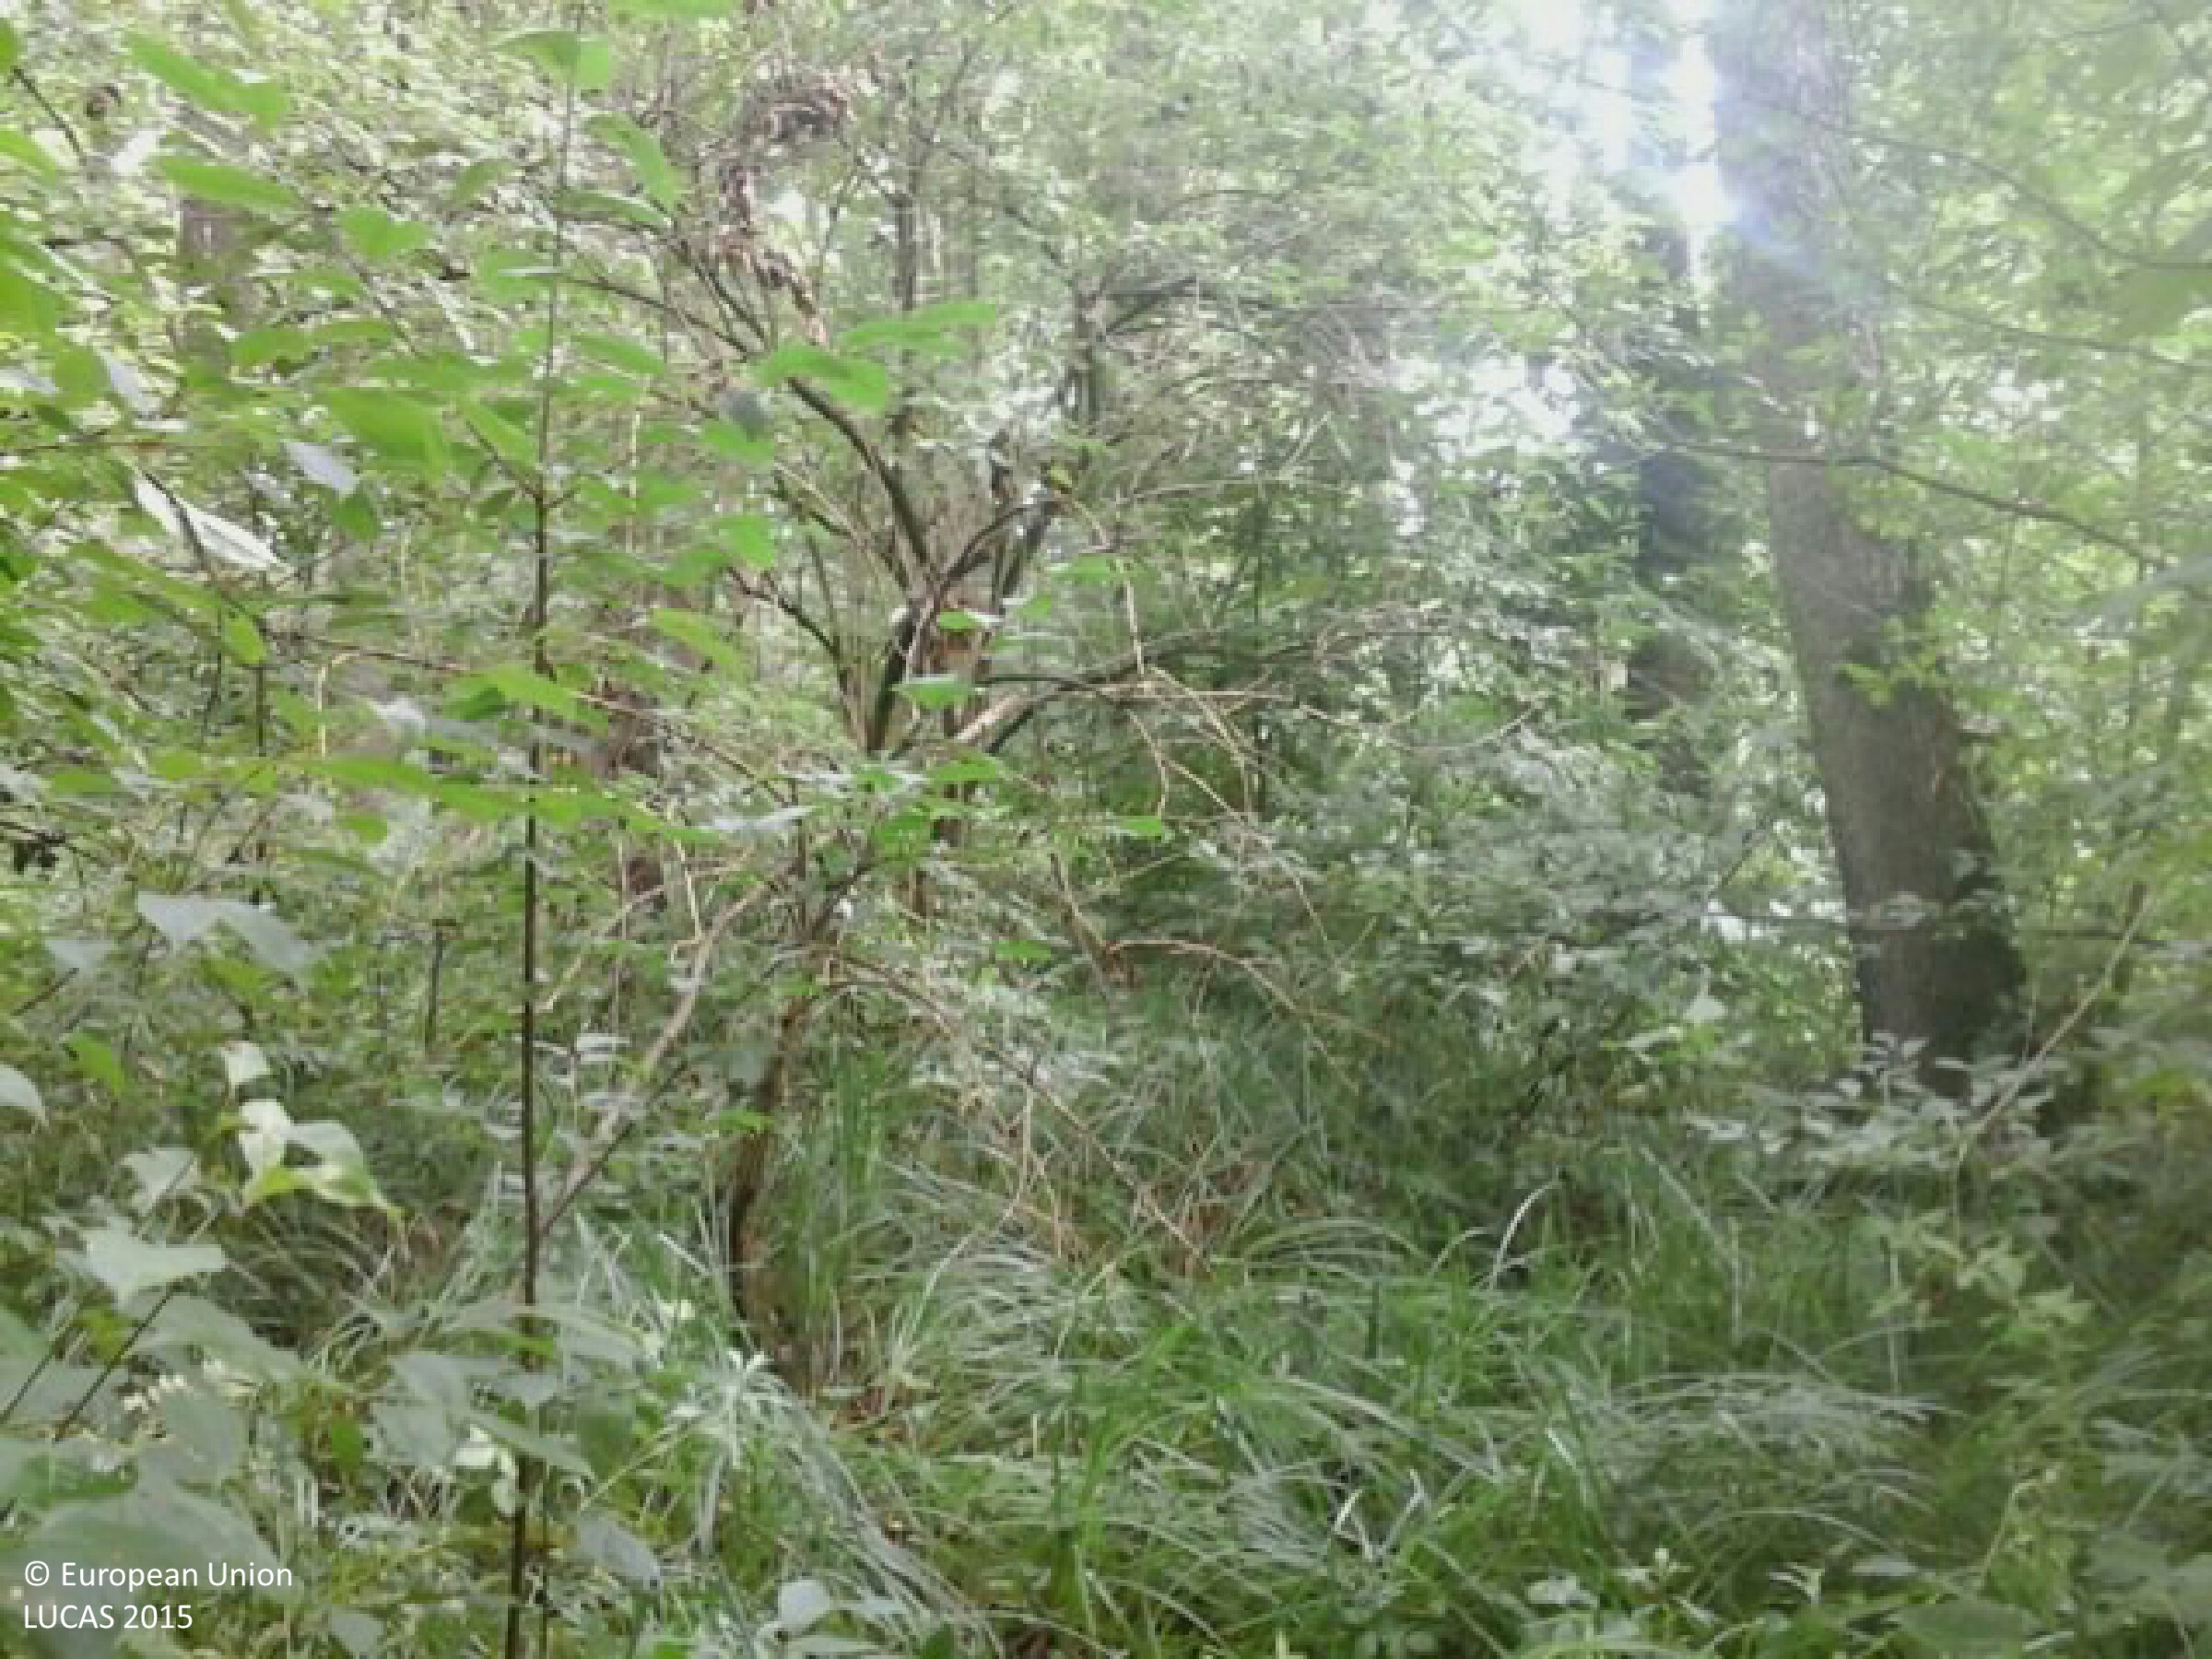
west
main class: Woodland
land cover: Broadleaved woodland
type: mesophytic deciduous forest
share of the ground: > 75 %
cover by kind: broadleaved forest trees 90 %, shrubs 5 %, herbaceous plants 5 %
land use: Semi-natural and natural areas not in use
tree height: > 5 m
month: July
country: HU
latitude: 46.3801
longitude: 17.1932
